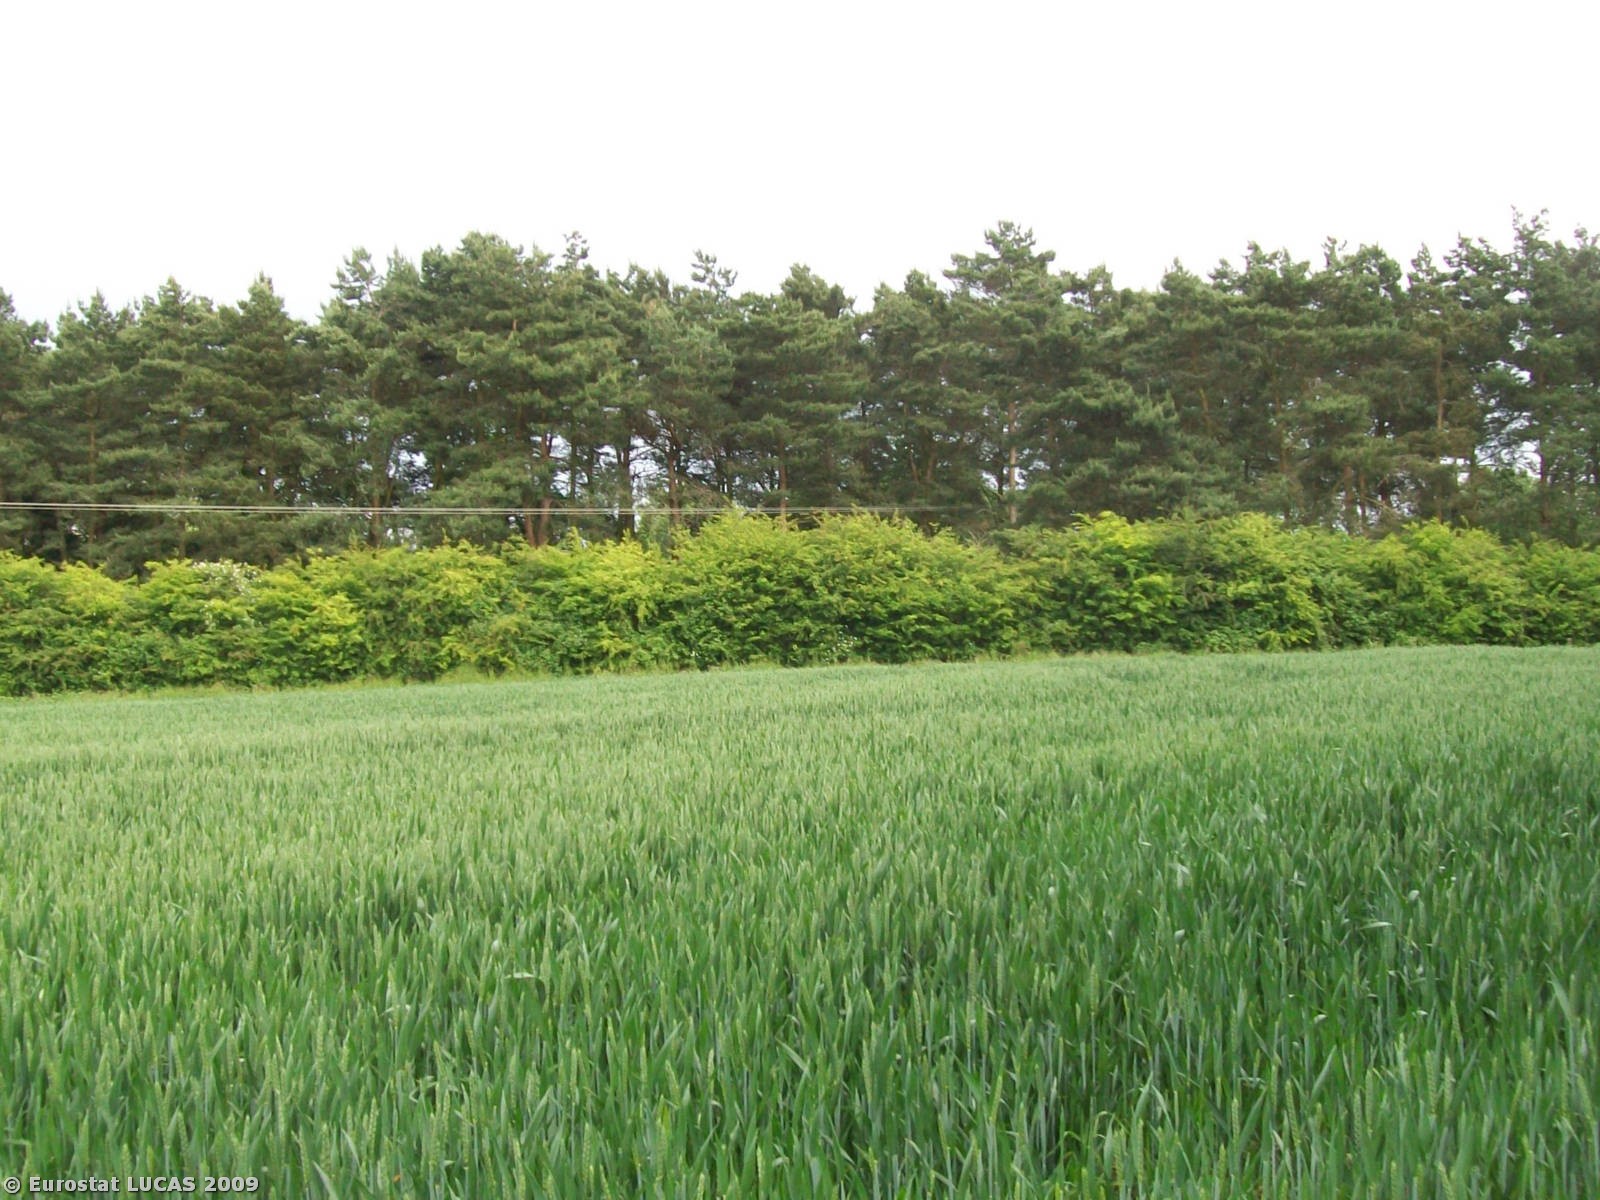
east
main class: Cropland
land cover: Common wheat
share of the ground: > 75 %
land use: Agriculture (excluding fallow land and kitchen gardens)
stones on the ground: 10 - 25 %
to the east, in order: Common wheat; Abandoned hedges; Grassland without tree/shrub cover; Electric lines; Grassland without tree/shrub cover; Mixed woodland; Grassland without tree/shrub cover; Tracks; Grassland without tree/shrub cover; Abandoned hedges; Grassland without tree/shrub cover; Mixed woodland
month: June
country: GB
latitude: 51.0713
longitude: -0.3551
